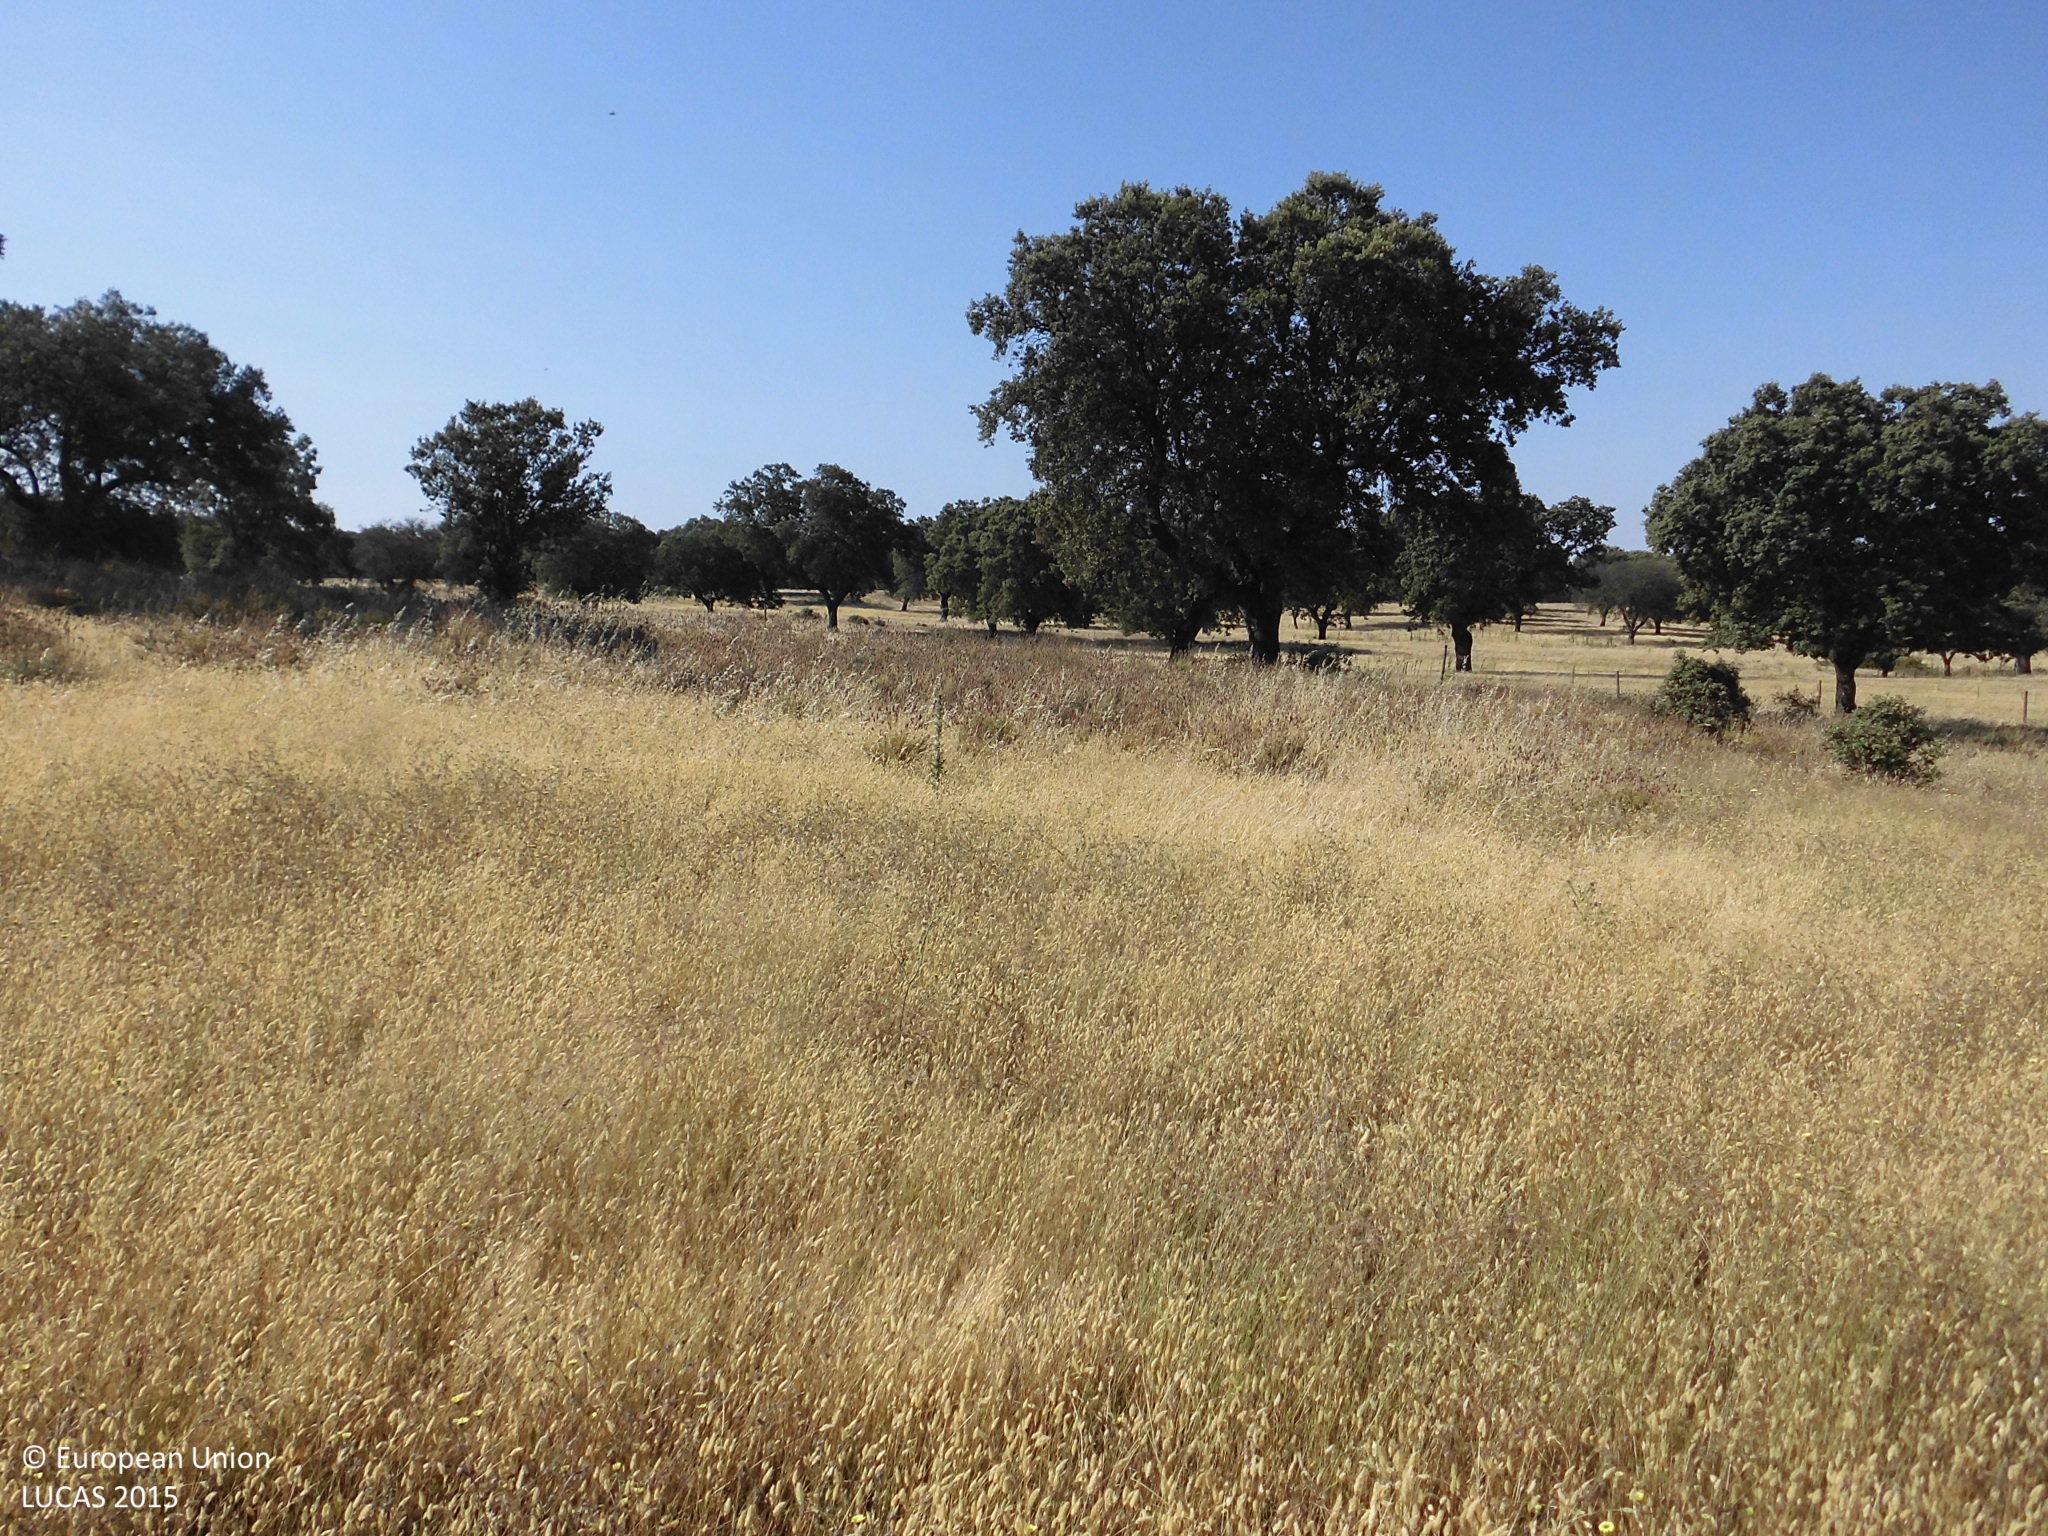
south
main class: Woodland
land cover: Broadleaved woodland
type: broadleaved evergreen forest
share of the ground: 50 - 75 %
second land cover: Grassland without tree/shrub cover
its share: > 75 %
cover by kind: herbaceous plants 70 %, broadleaved forest trees 25 %, shrubs 5 %
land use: Forestry
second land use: Agriculture (excluding fallow land and kitchen gardens)
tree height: > 5 m
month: June
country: ES
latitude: 40.0322
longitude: -5.4222
